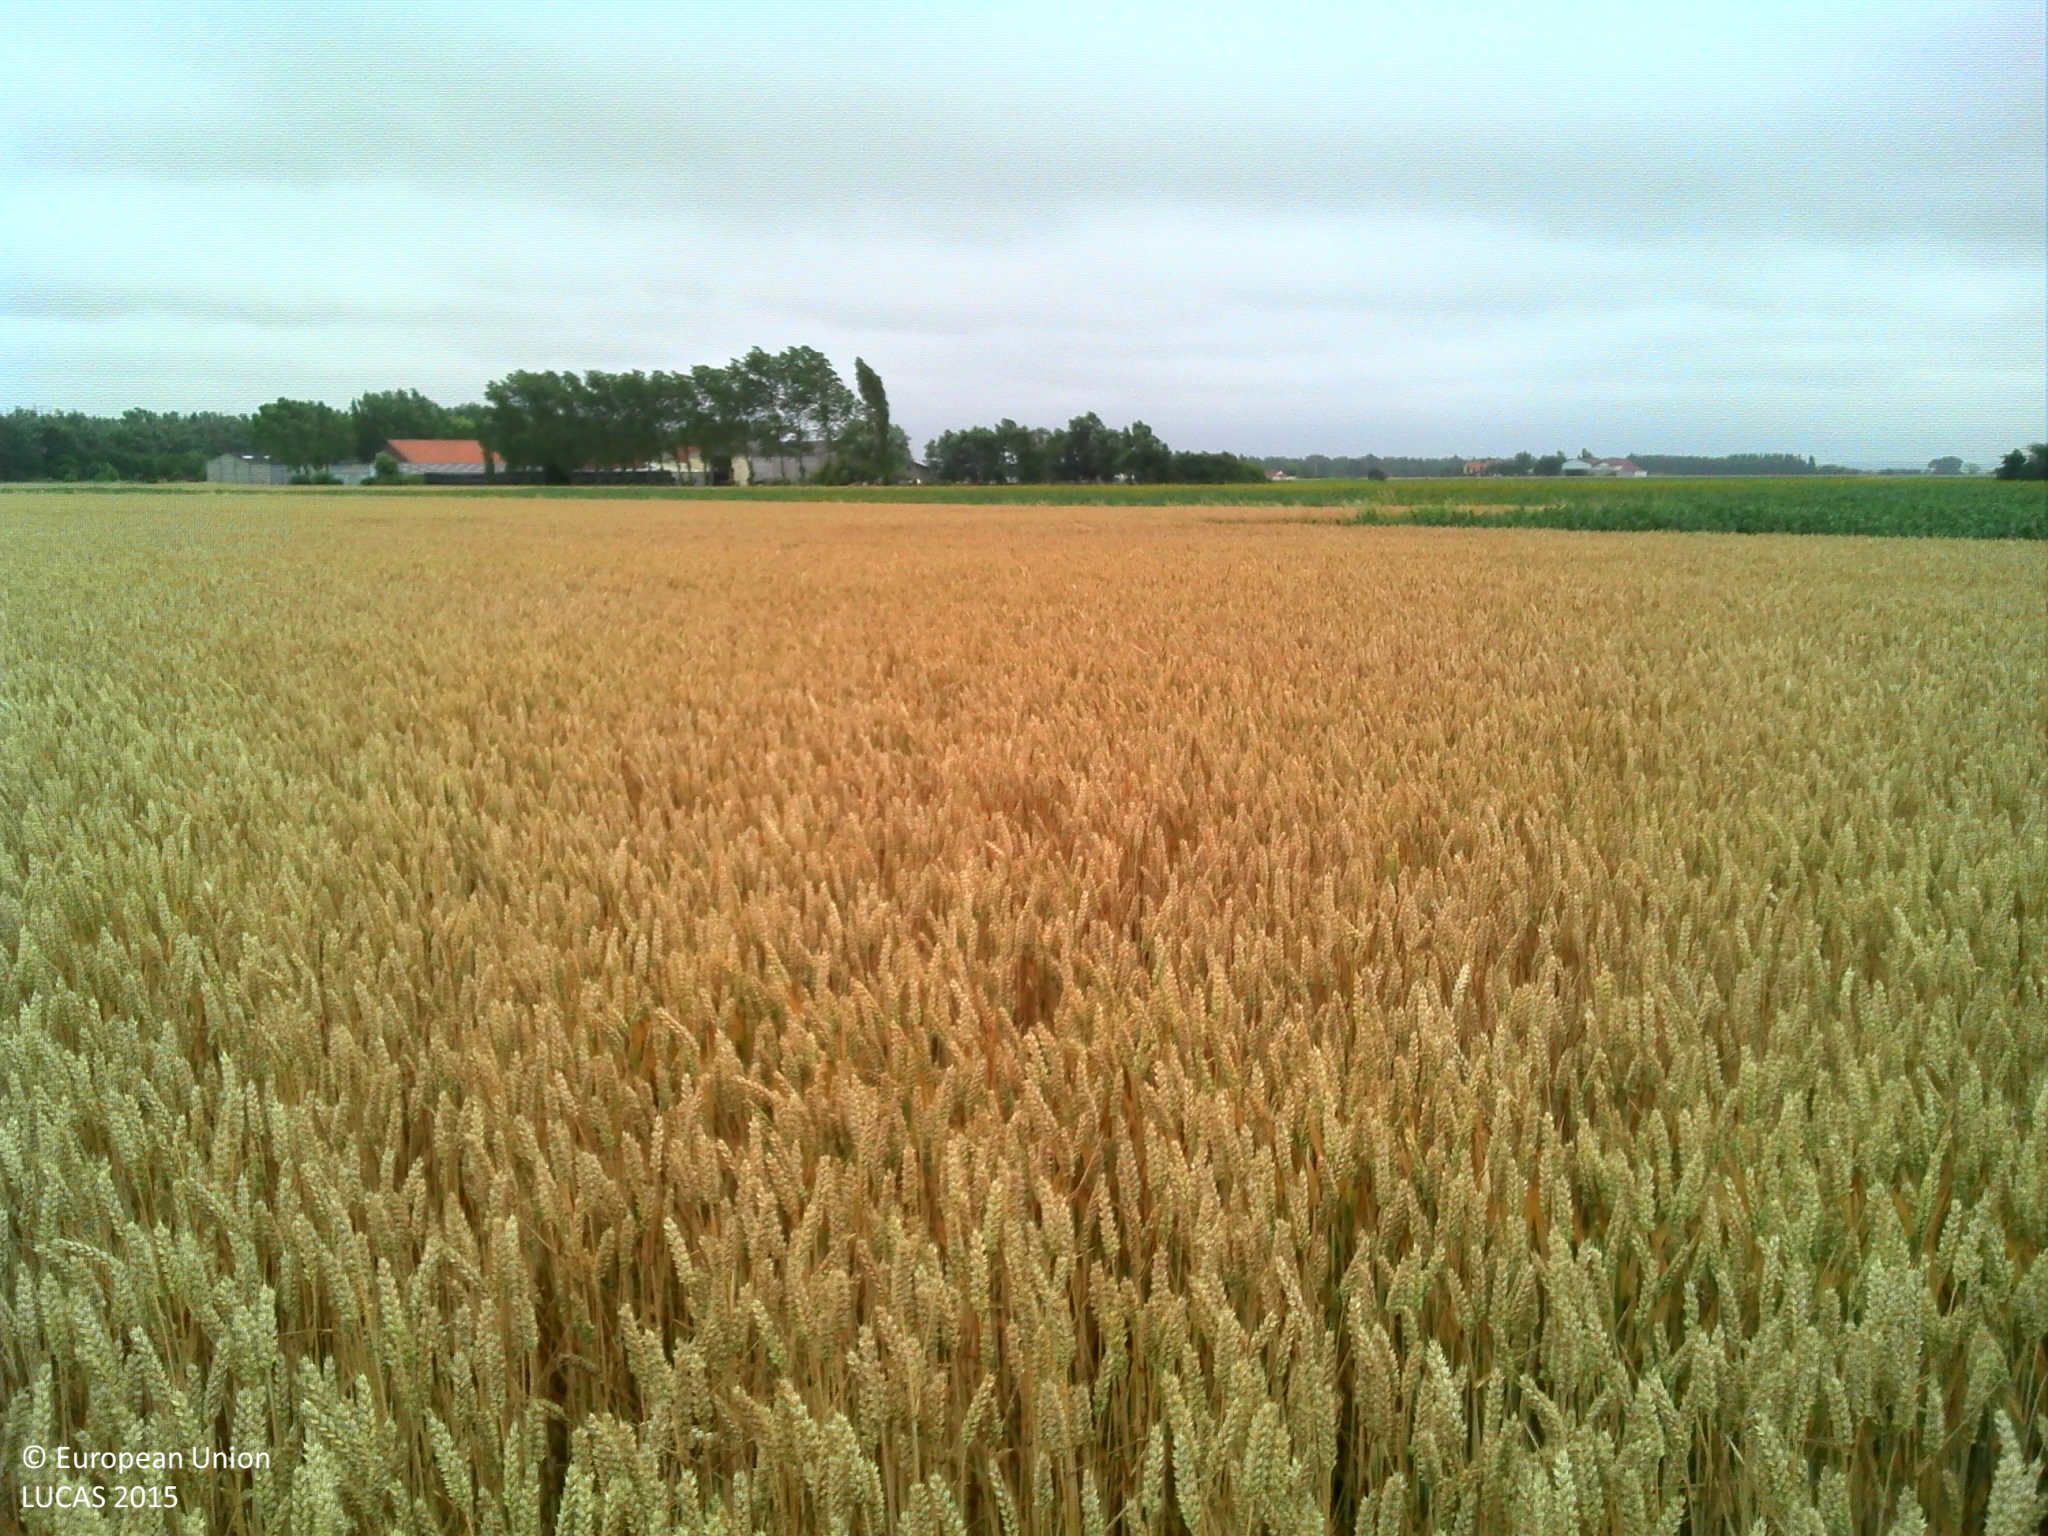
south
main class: Cropland
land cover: Common wheat
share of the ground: > 75 %
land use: Agriculture (excluding fallow land and kitchen gardens)
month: July
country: FR
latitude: 50.9504
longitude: 2.2564
